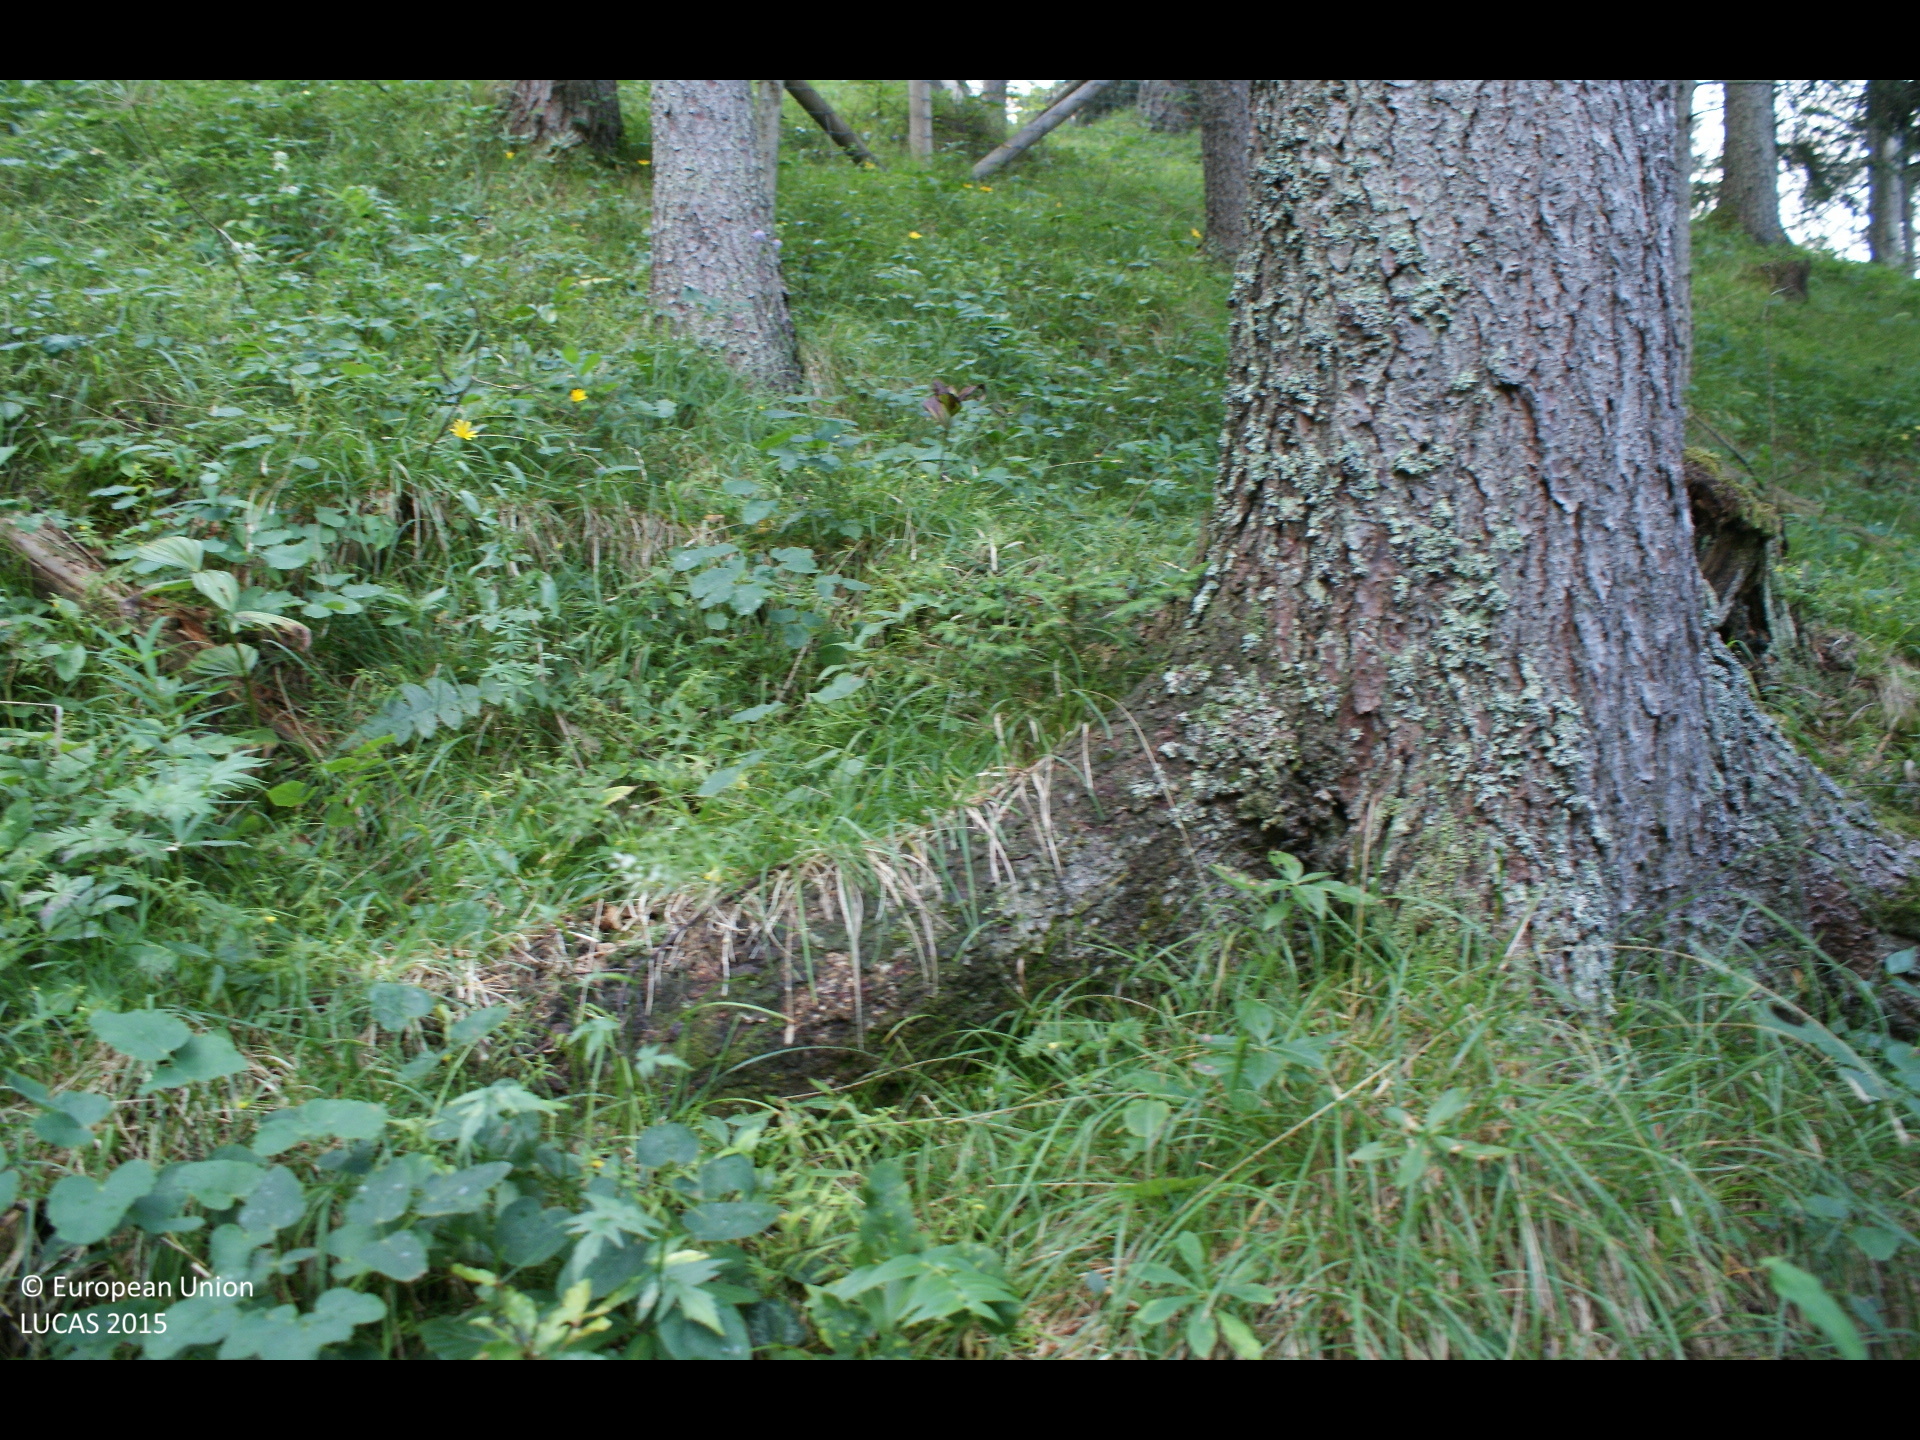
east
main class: Woodland
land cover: Spruce dominated coniferous woodland
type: alpine coniferous forest
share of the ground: 50 - 75 %
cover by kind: coniferous forest trees 55 %, herbaceous plants 30 %, shrubs 10 %, lichens and mosses 5 %
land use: Forestry
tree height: > 5 m
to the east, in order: Spruce dominated coniferous woodland; Fences; Spruce dominated coniferous woodland; Fences; Spruce dominated mixed woodland; Grassland with sparse tree/shrub cover; Spruce dominated coniferous woodland; Grassland with sparse tree/shrub cover; Spruce dominated coniferous woodland
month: August
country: AT
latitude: 47.7177
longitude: 15.2930
